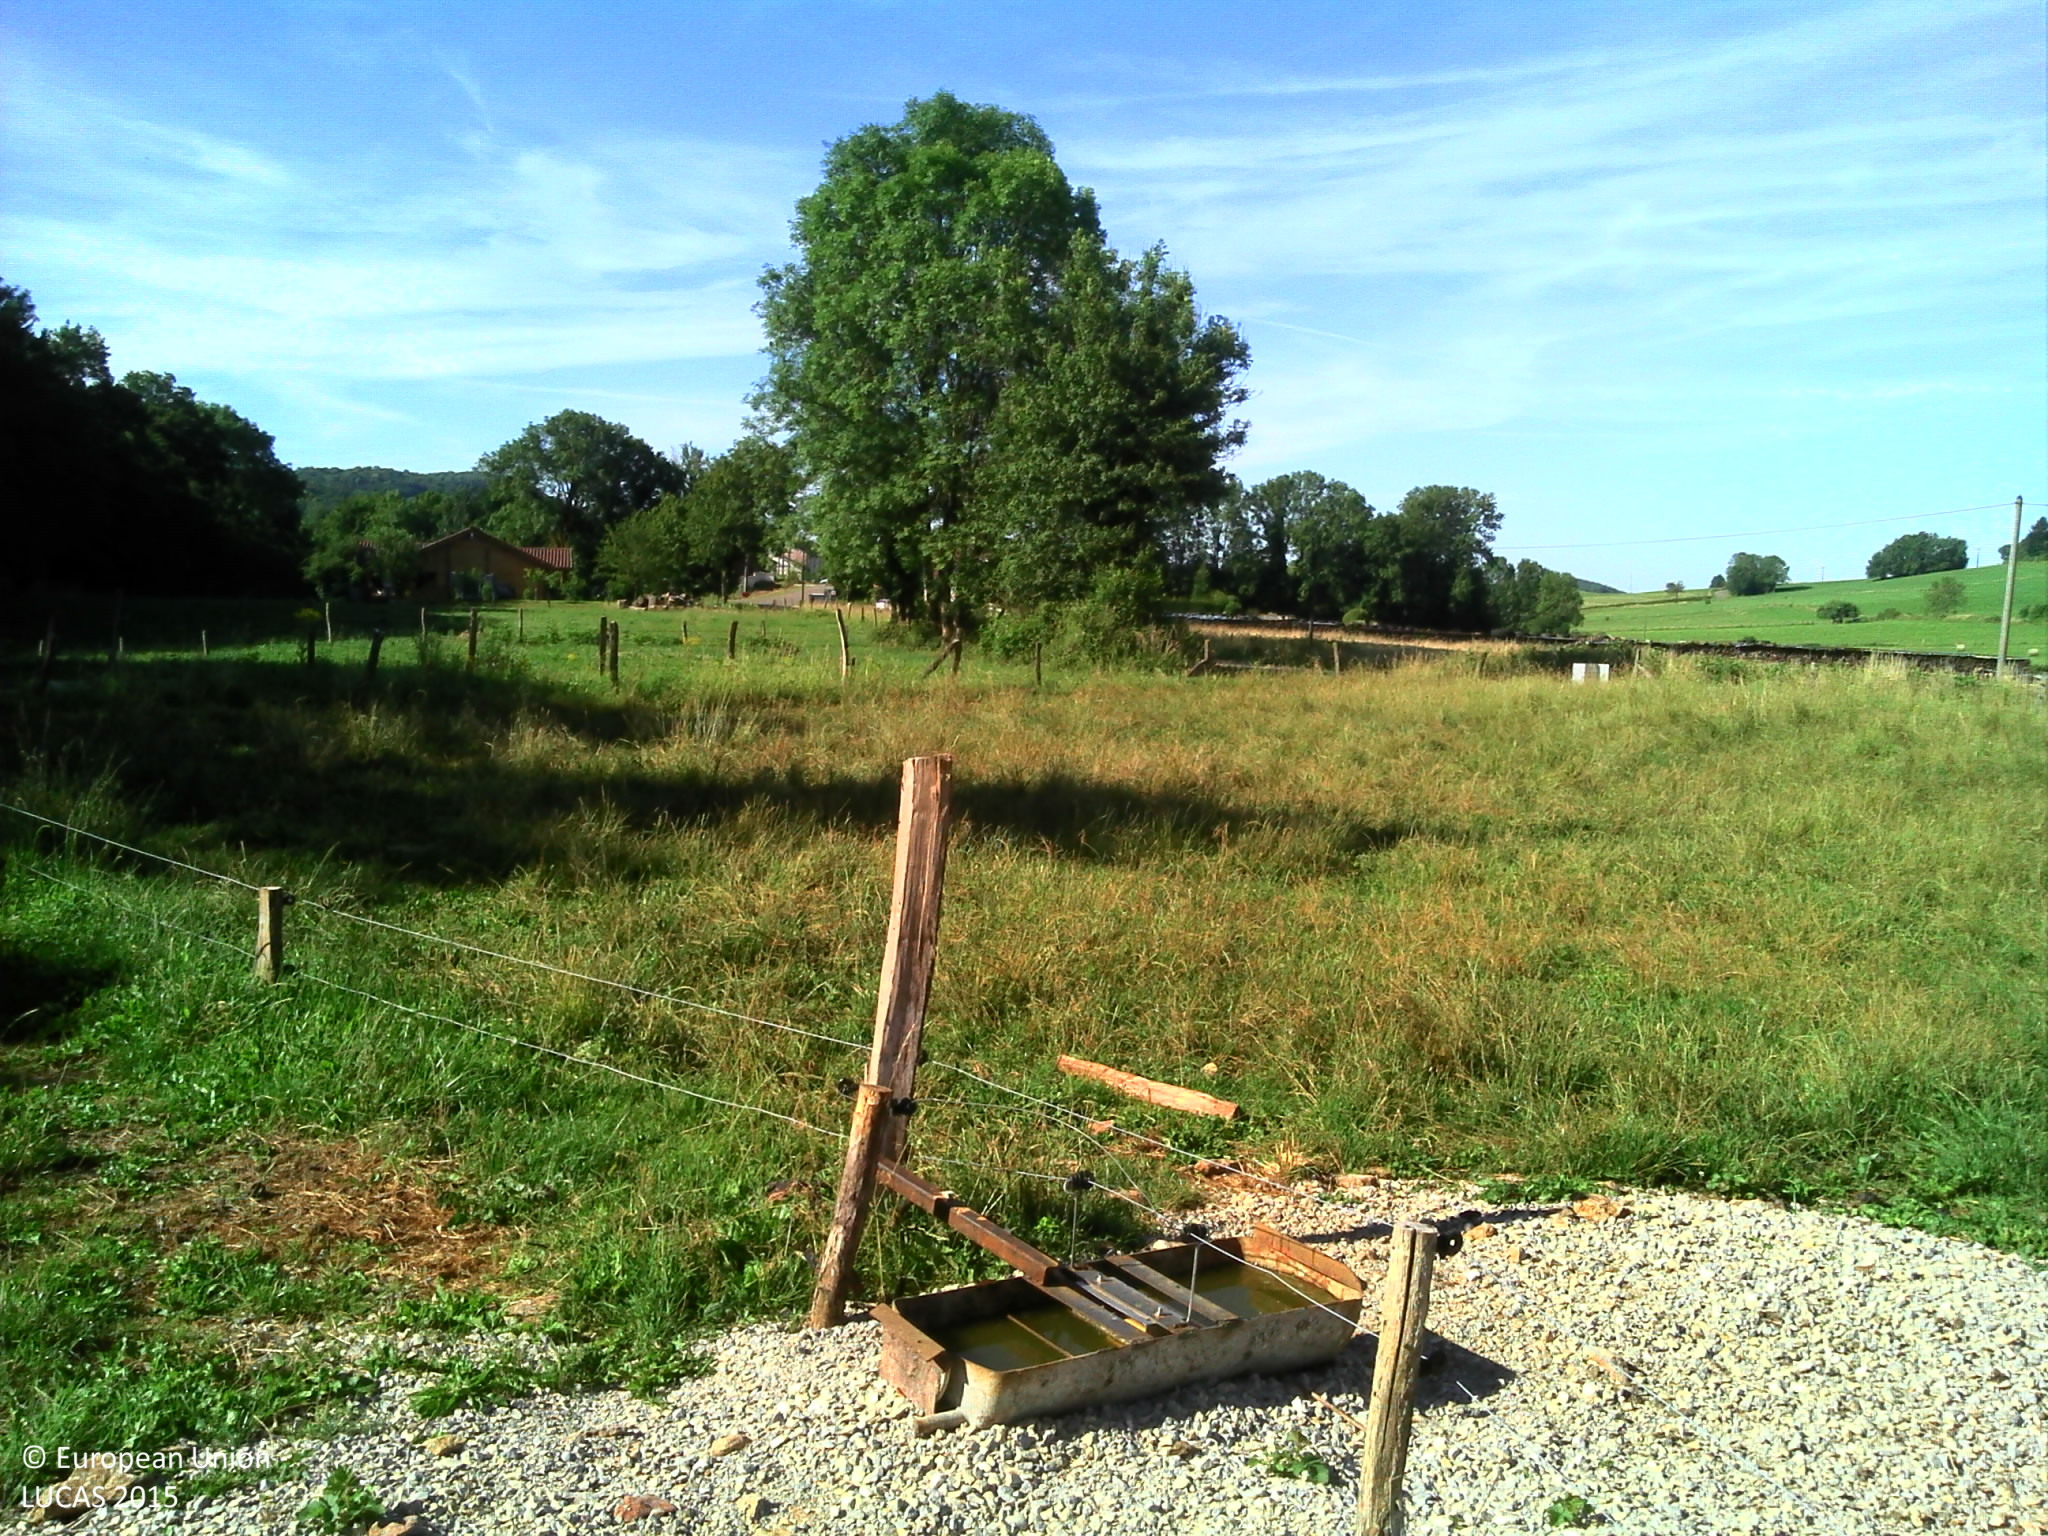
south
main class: Grassland
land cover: Grassland without tree/shrub cover
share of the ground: > 75 %
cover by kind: herbaceous plants 100 %
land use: Agriculture (excluding fallow land and kitchen gardens)
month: June
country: FR
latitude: 46.5093
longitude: 5.5064
